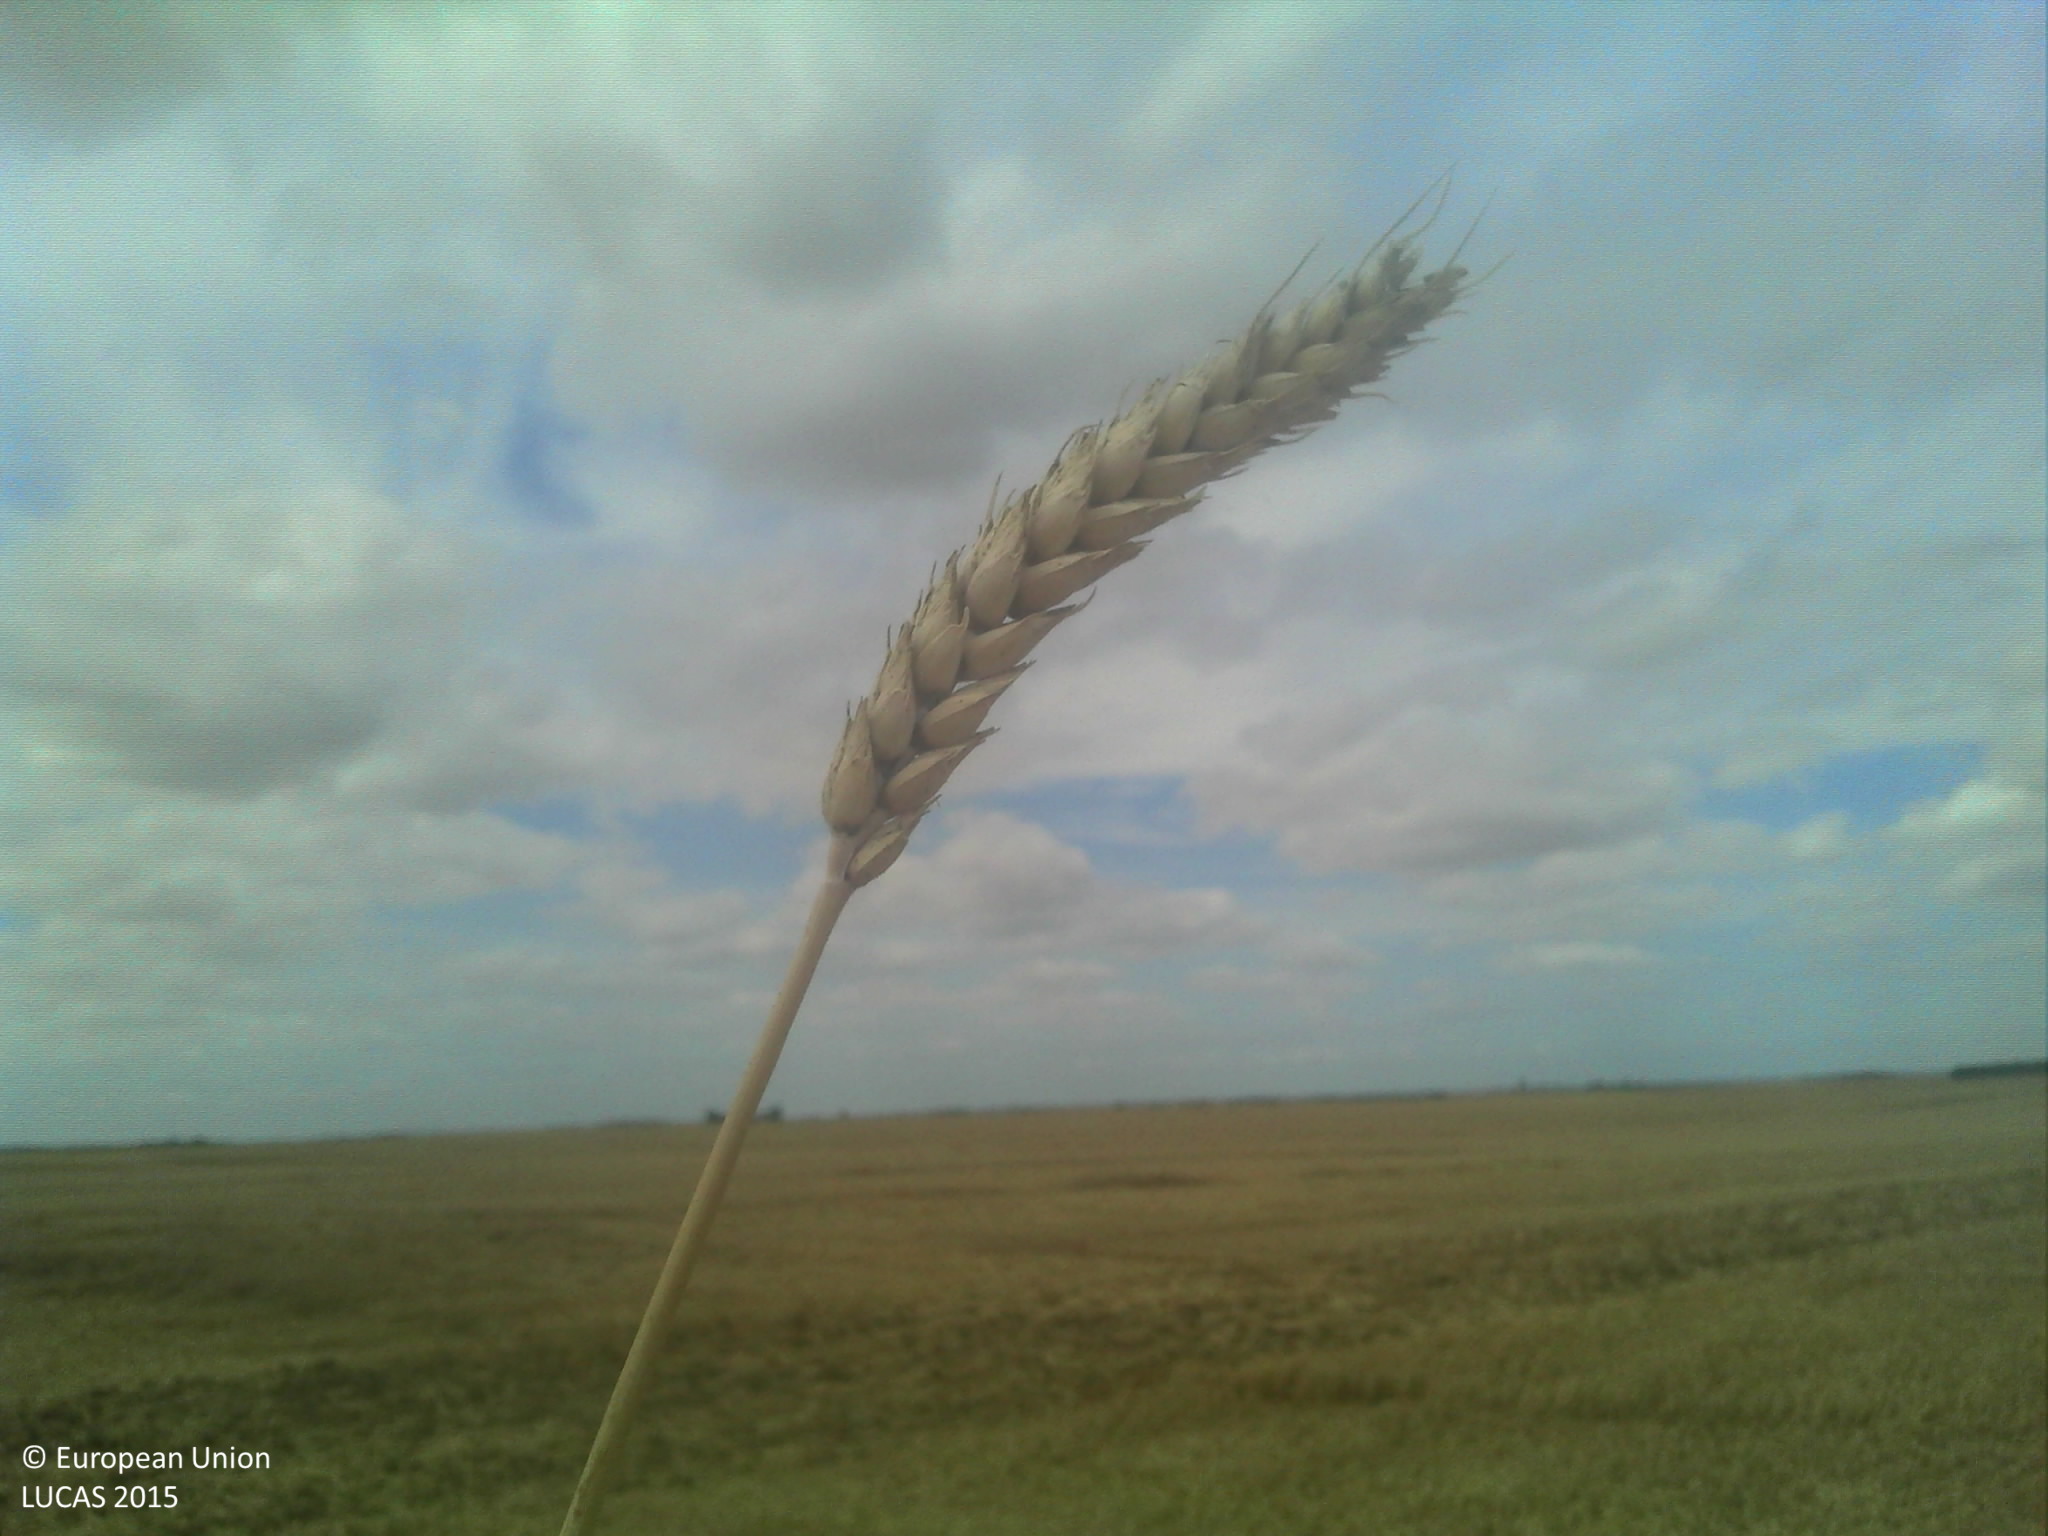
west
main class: Cropland
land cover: Common wheat
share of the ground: > 75 %
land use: Agriculture (excluding fallow land and kitchen gardens)
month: July
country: FR
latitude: 47.7629
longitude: 1.4327
